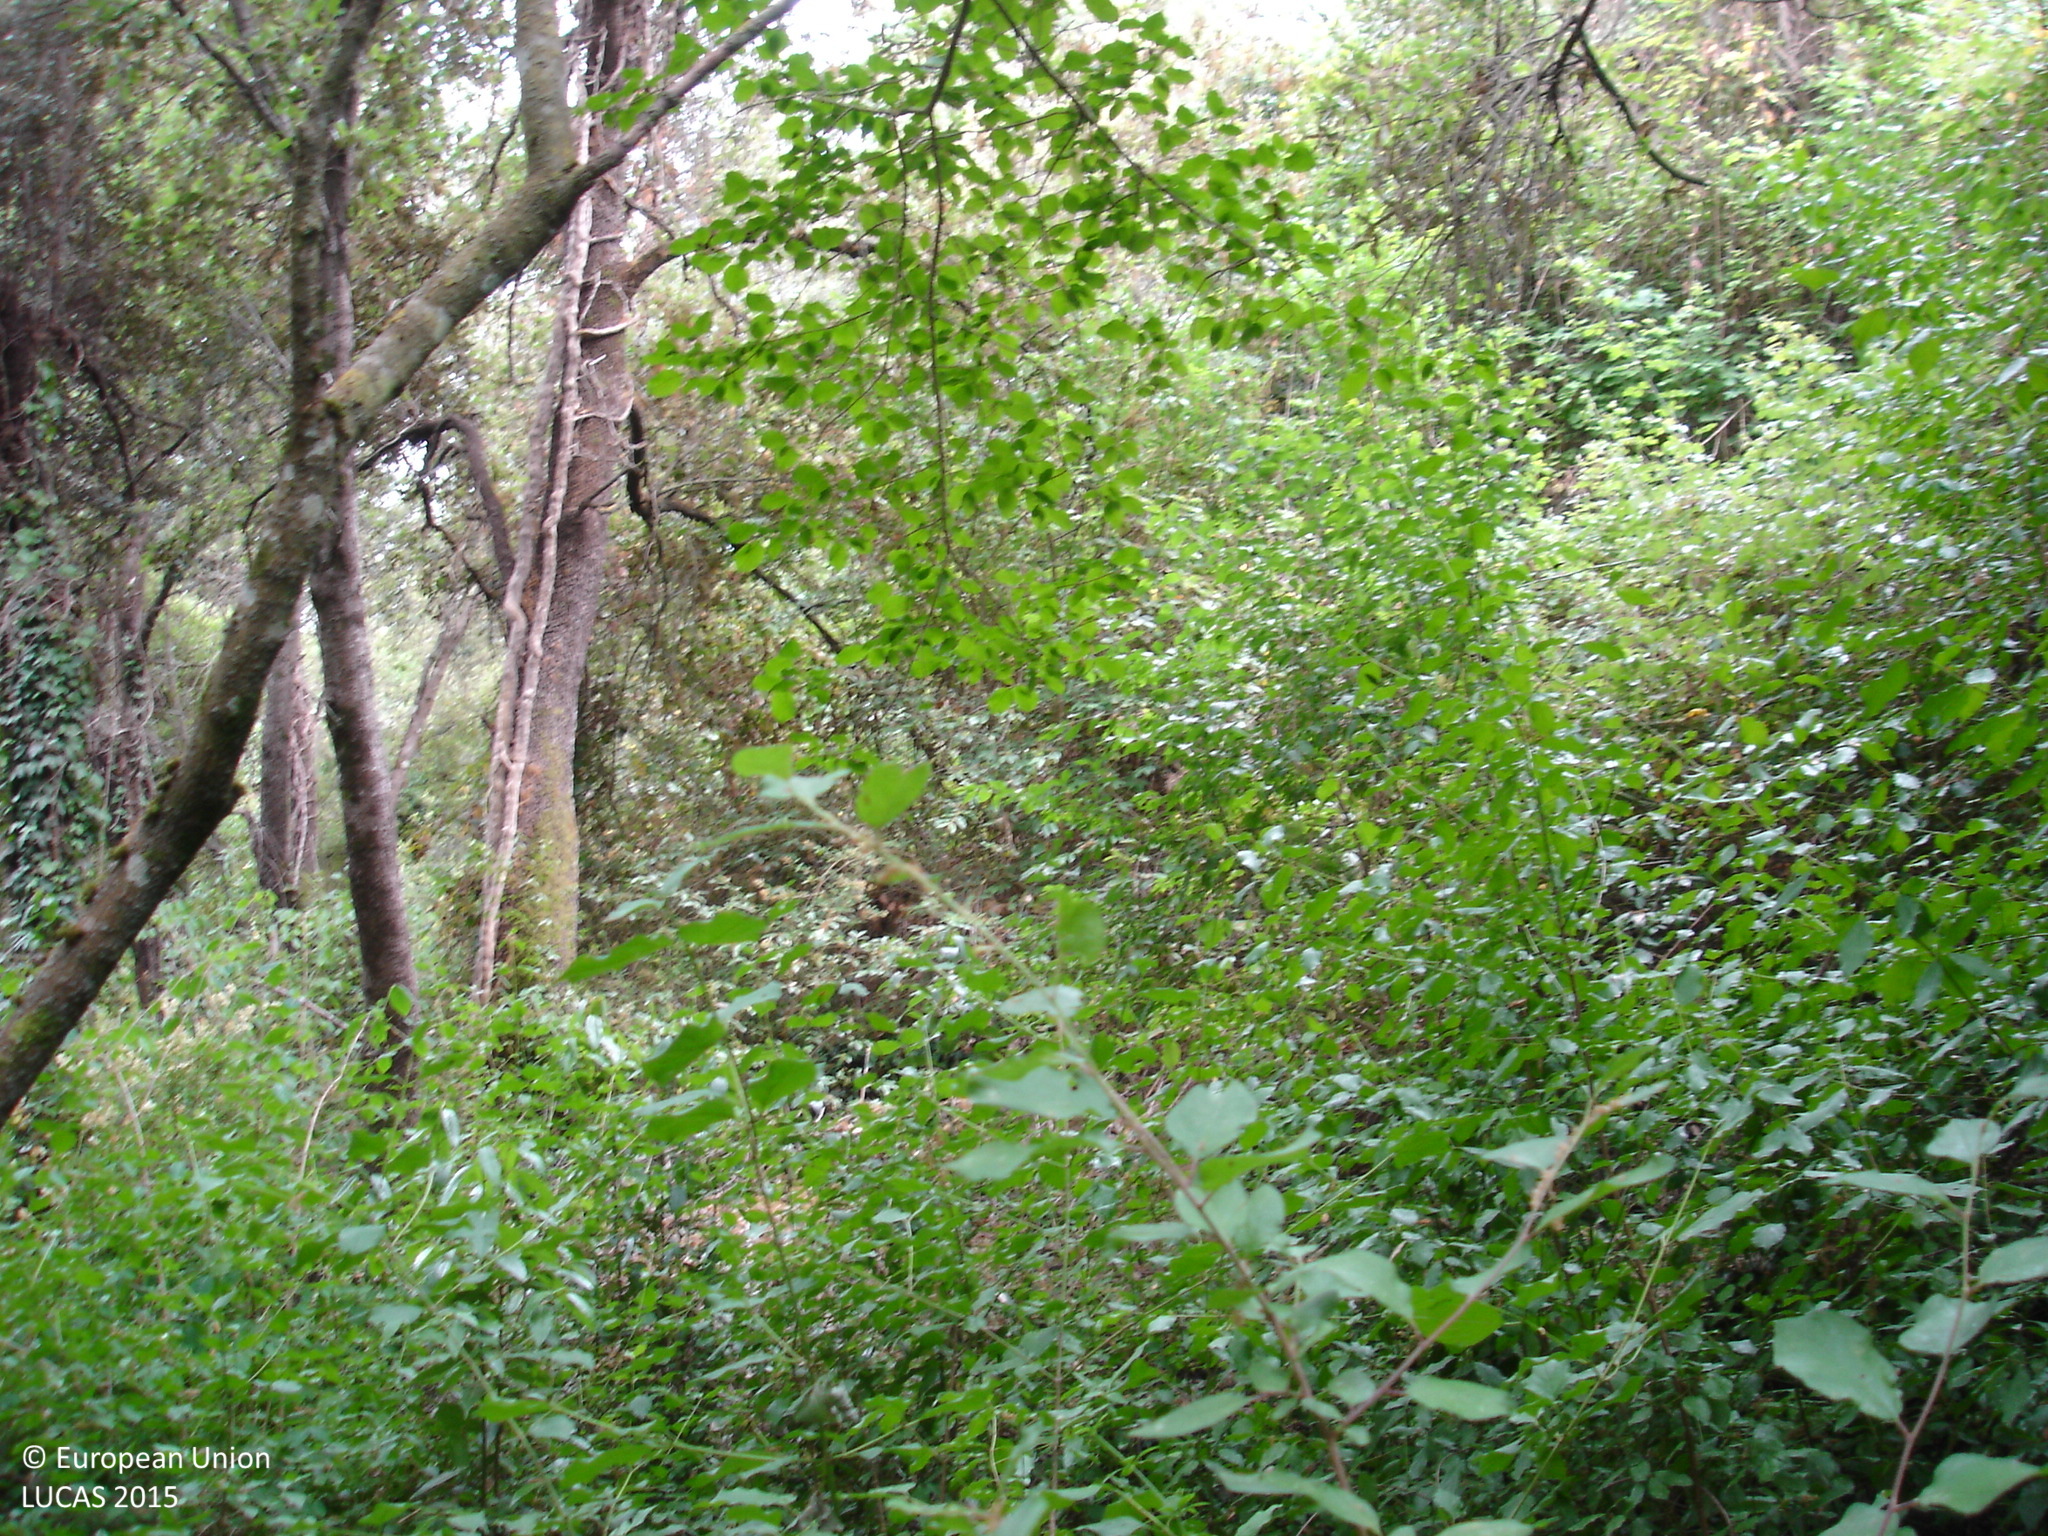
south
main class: Woodland
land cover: Broadleaved woodland
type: thermophilous deciduous forest
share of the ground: > 75 %
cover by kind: broadleaved forest trees 90 %, shrubs 10 %
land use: Forestry
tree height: > 5 m
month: June
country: ES
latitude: 41.7532
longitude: 2.1866
